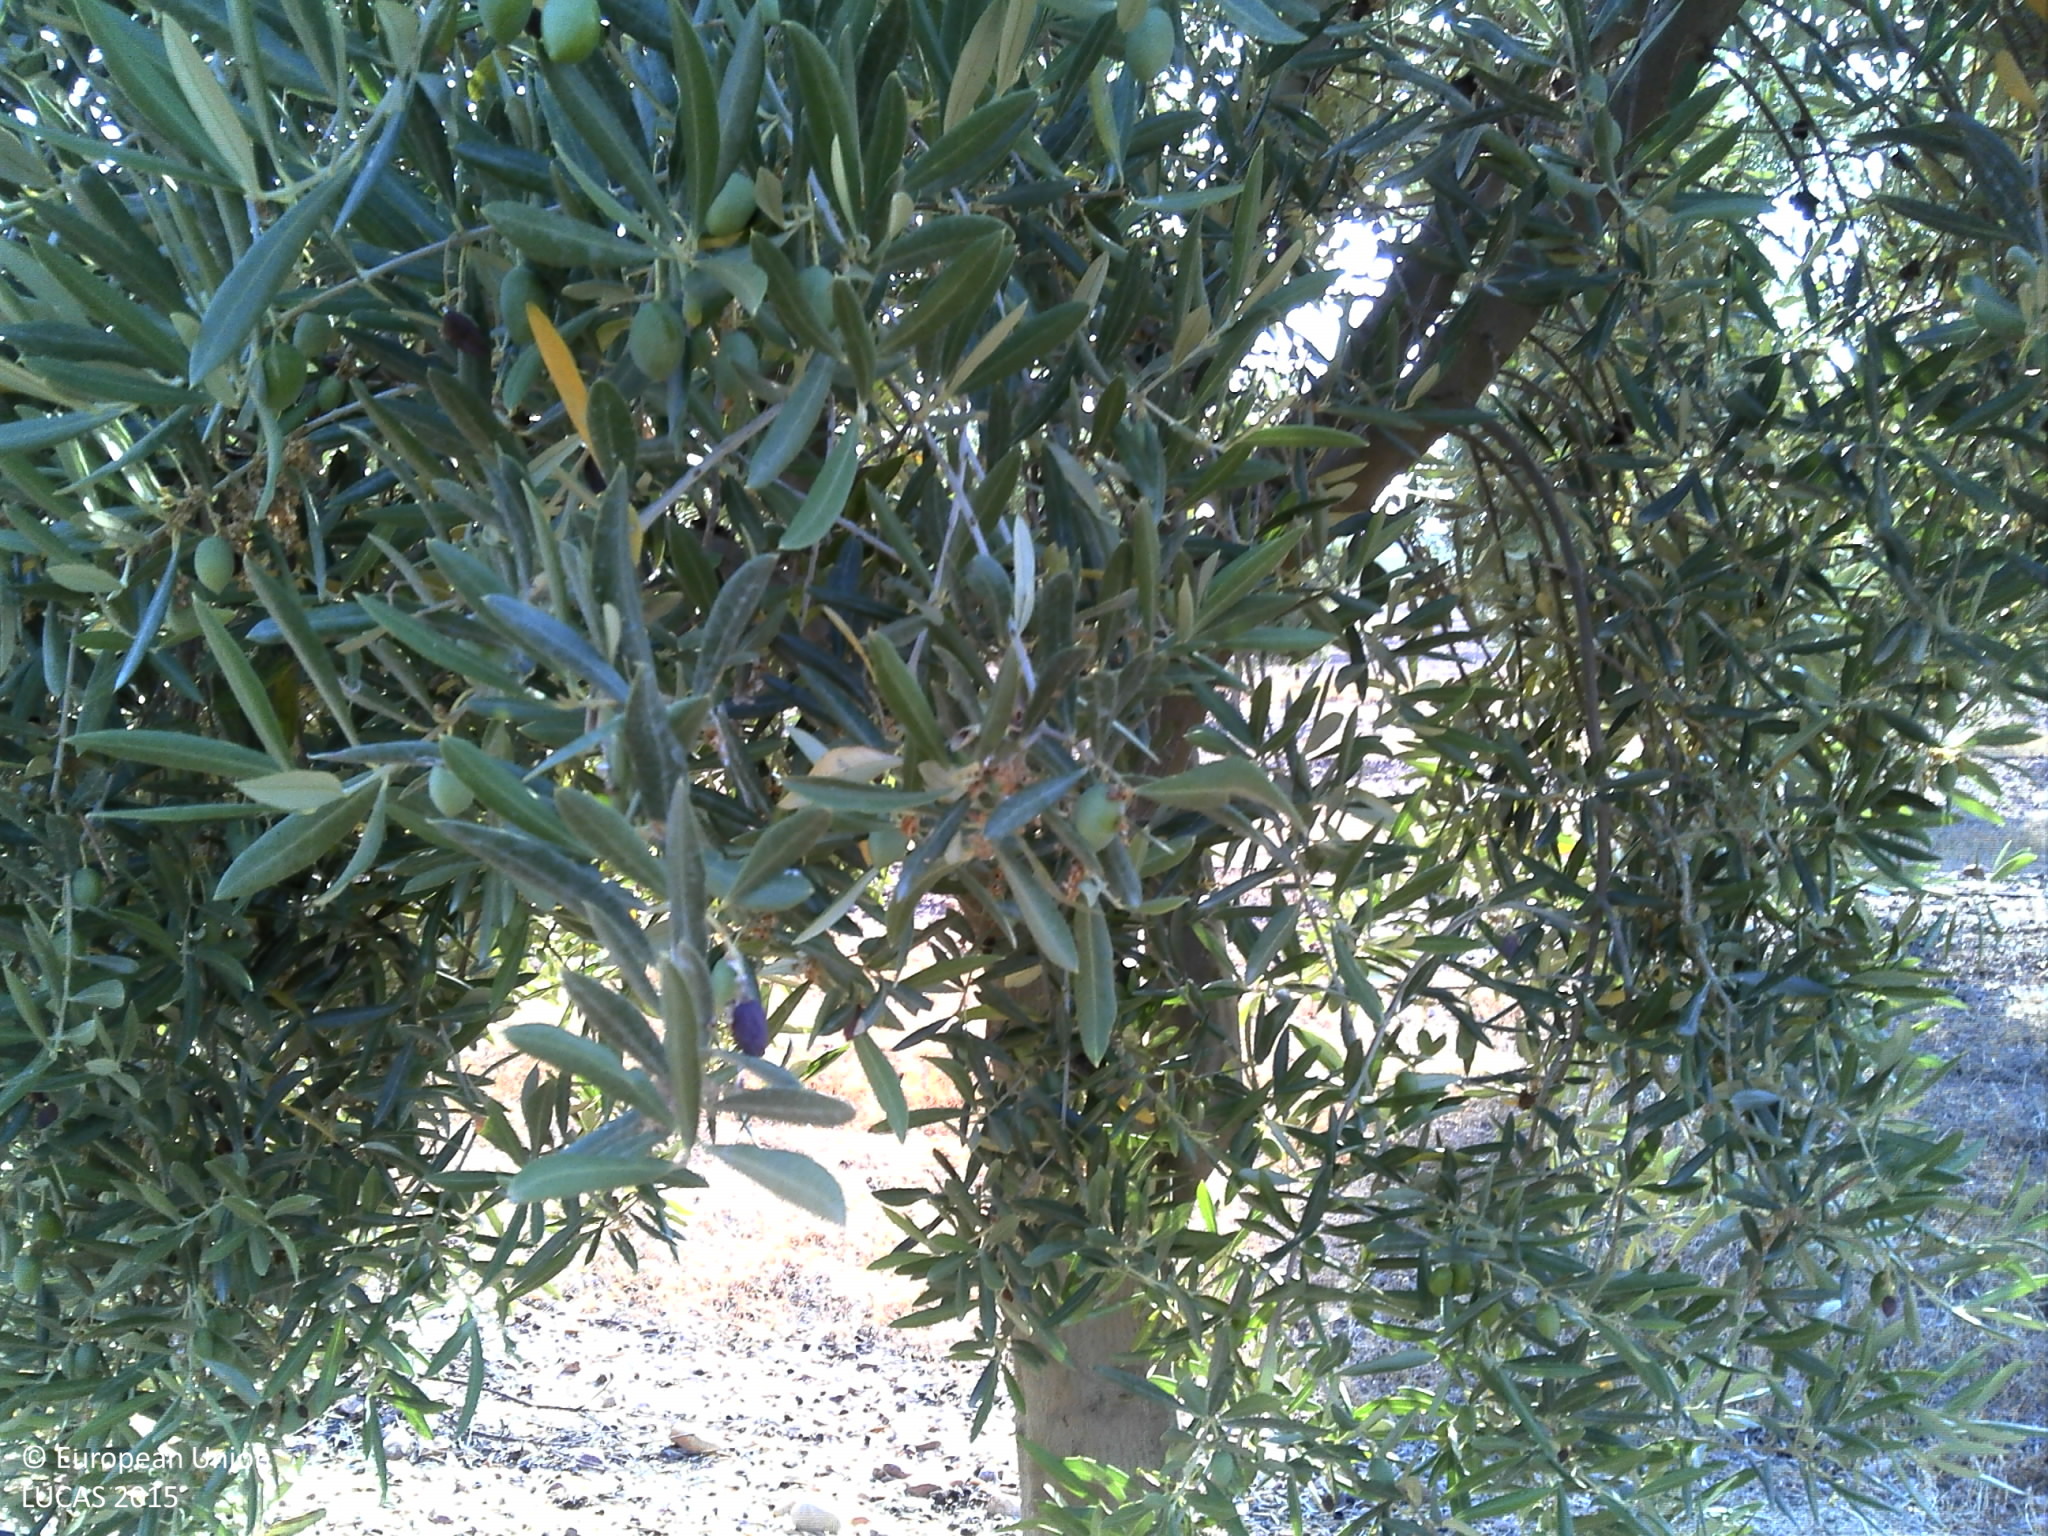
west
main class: Cropland
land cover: Olive groves
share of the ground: 25 - 50 %
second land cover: Grassland without tree/shrub cover
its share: 10 - 25 %
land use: Agriculture (excluding fallow land and kitchen gardens)
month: June
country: PT
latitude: 38.1517
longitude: -7.5630
